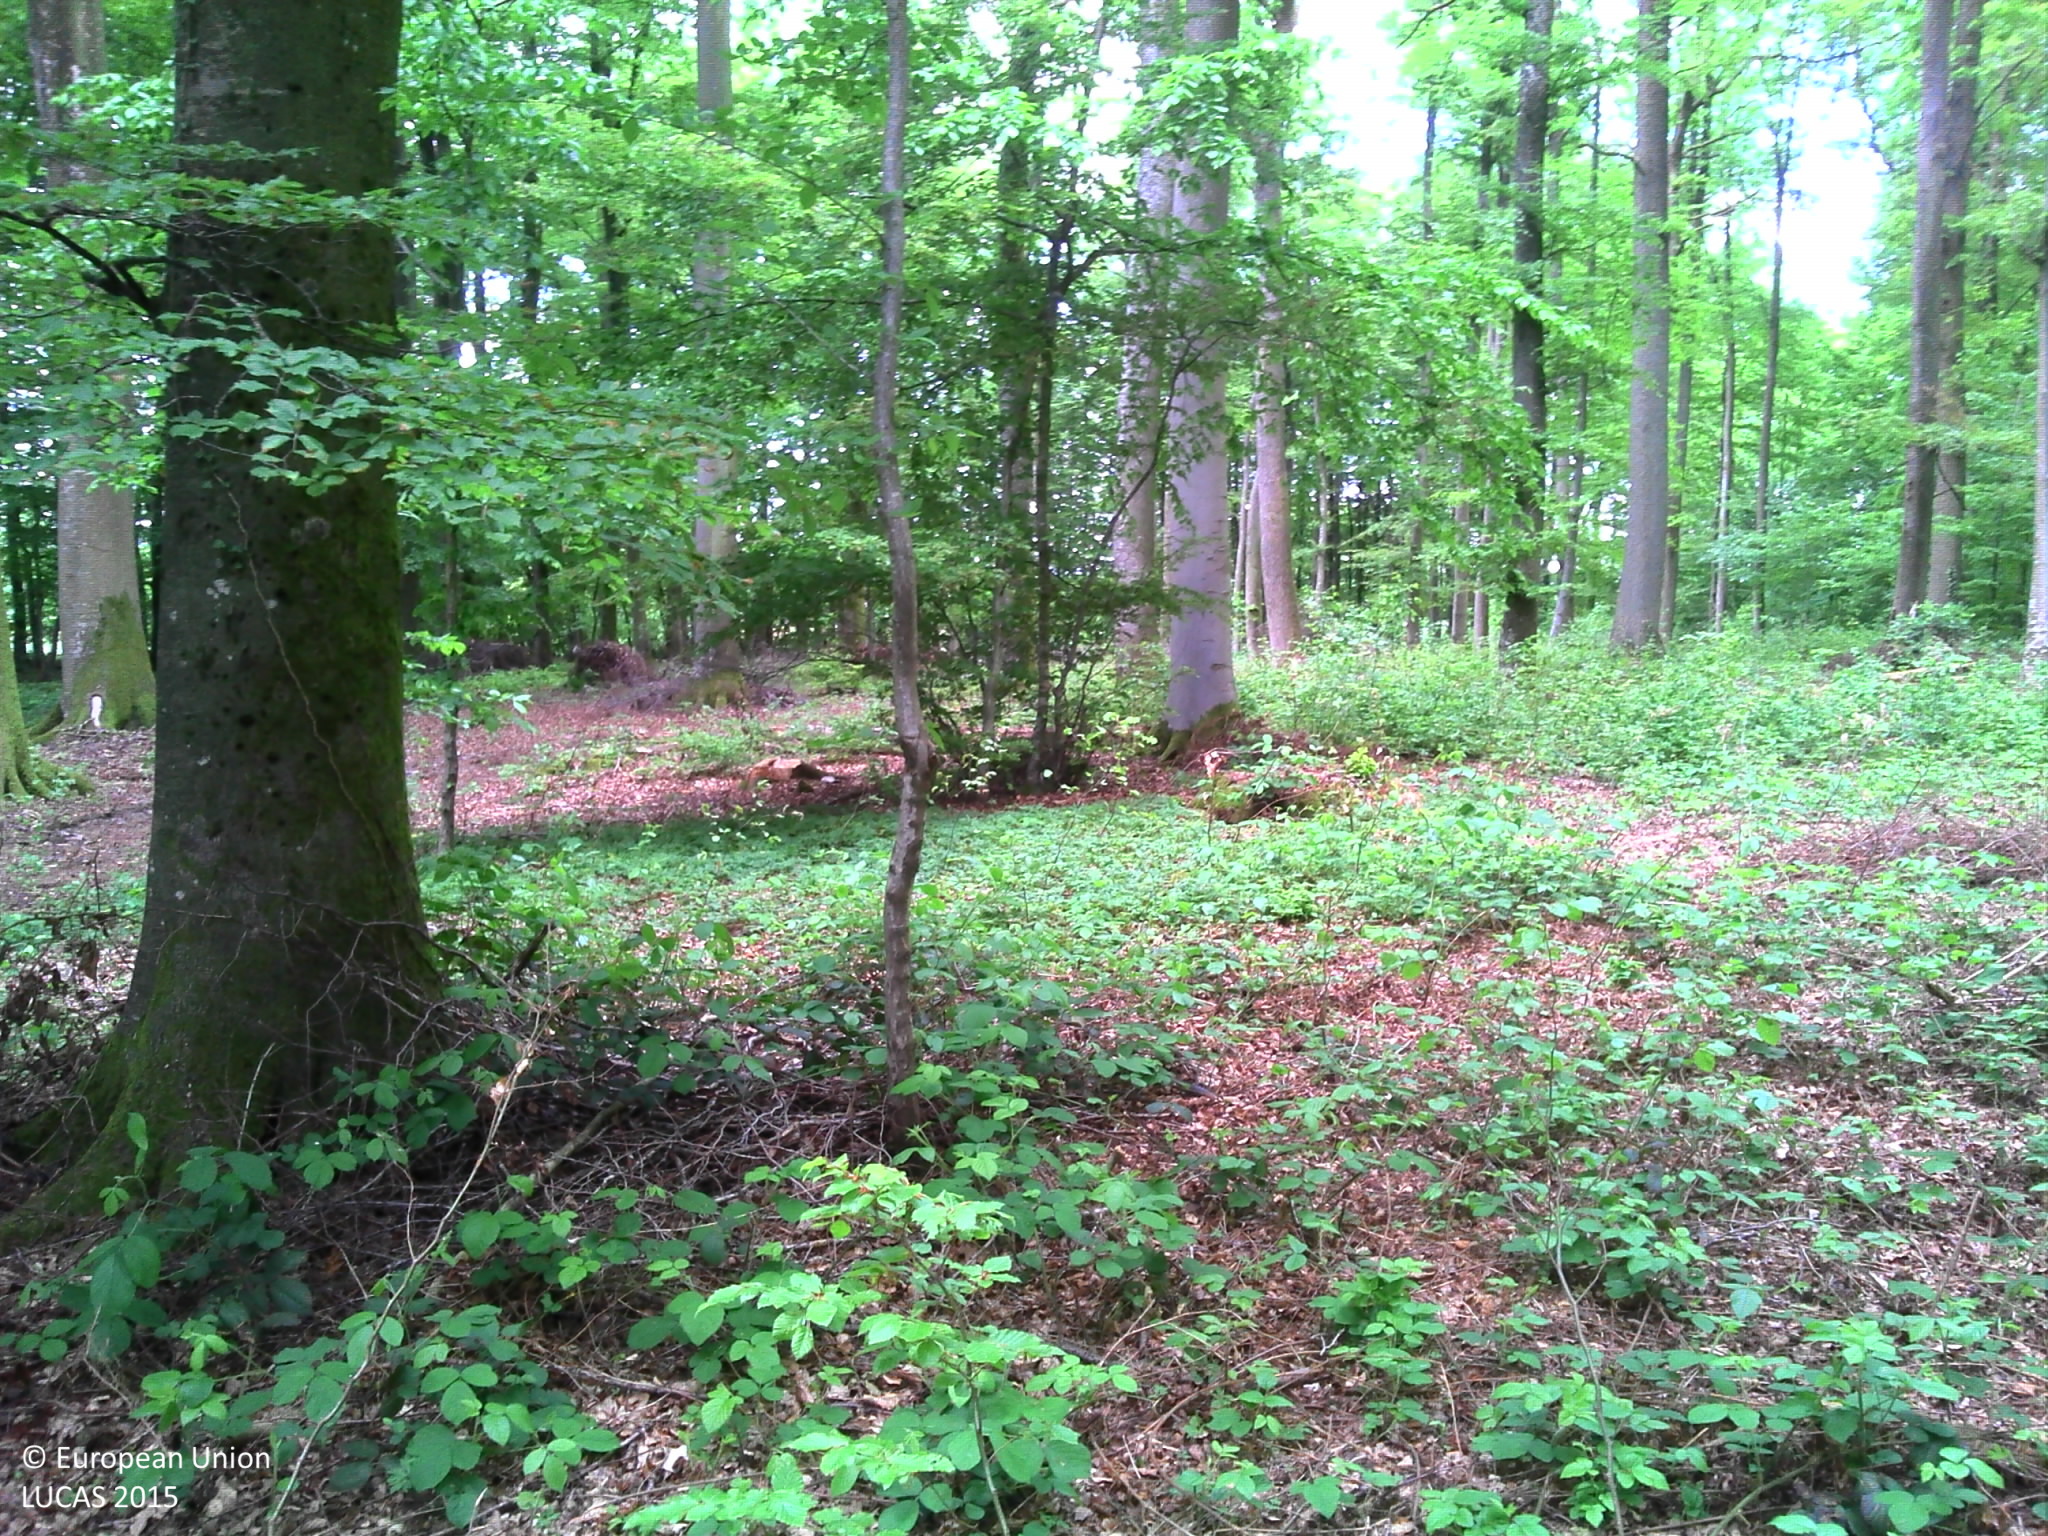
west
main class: Woodland
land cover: Broadleaved woodland
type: beech forest
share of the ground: > 75 %
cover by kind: broadleaved forest trees 85 %, herbaceous plants 10 %, lichens and mosses 5 %
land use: Forestry
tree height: > 5 m
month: May
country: LU
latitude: 49.7685
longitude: 5.9032
